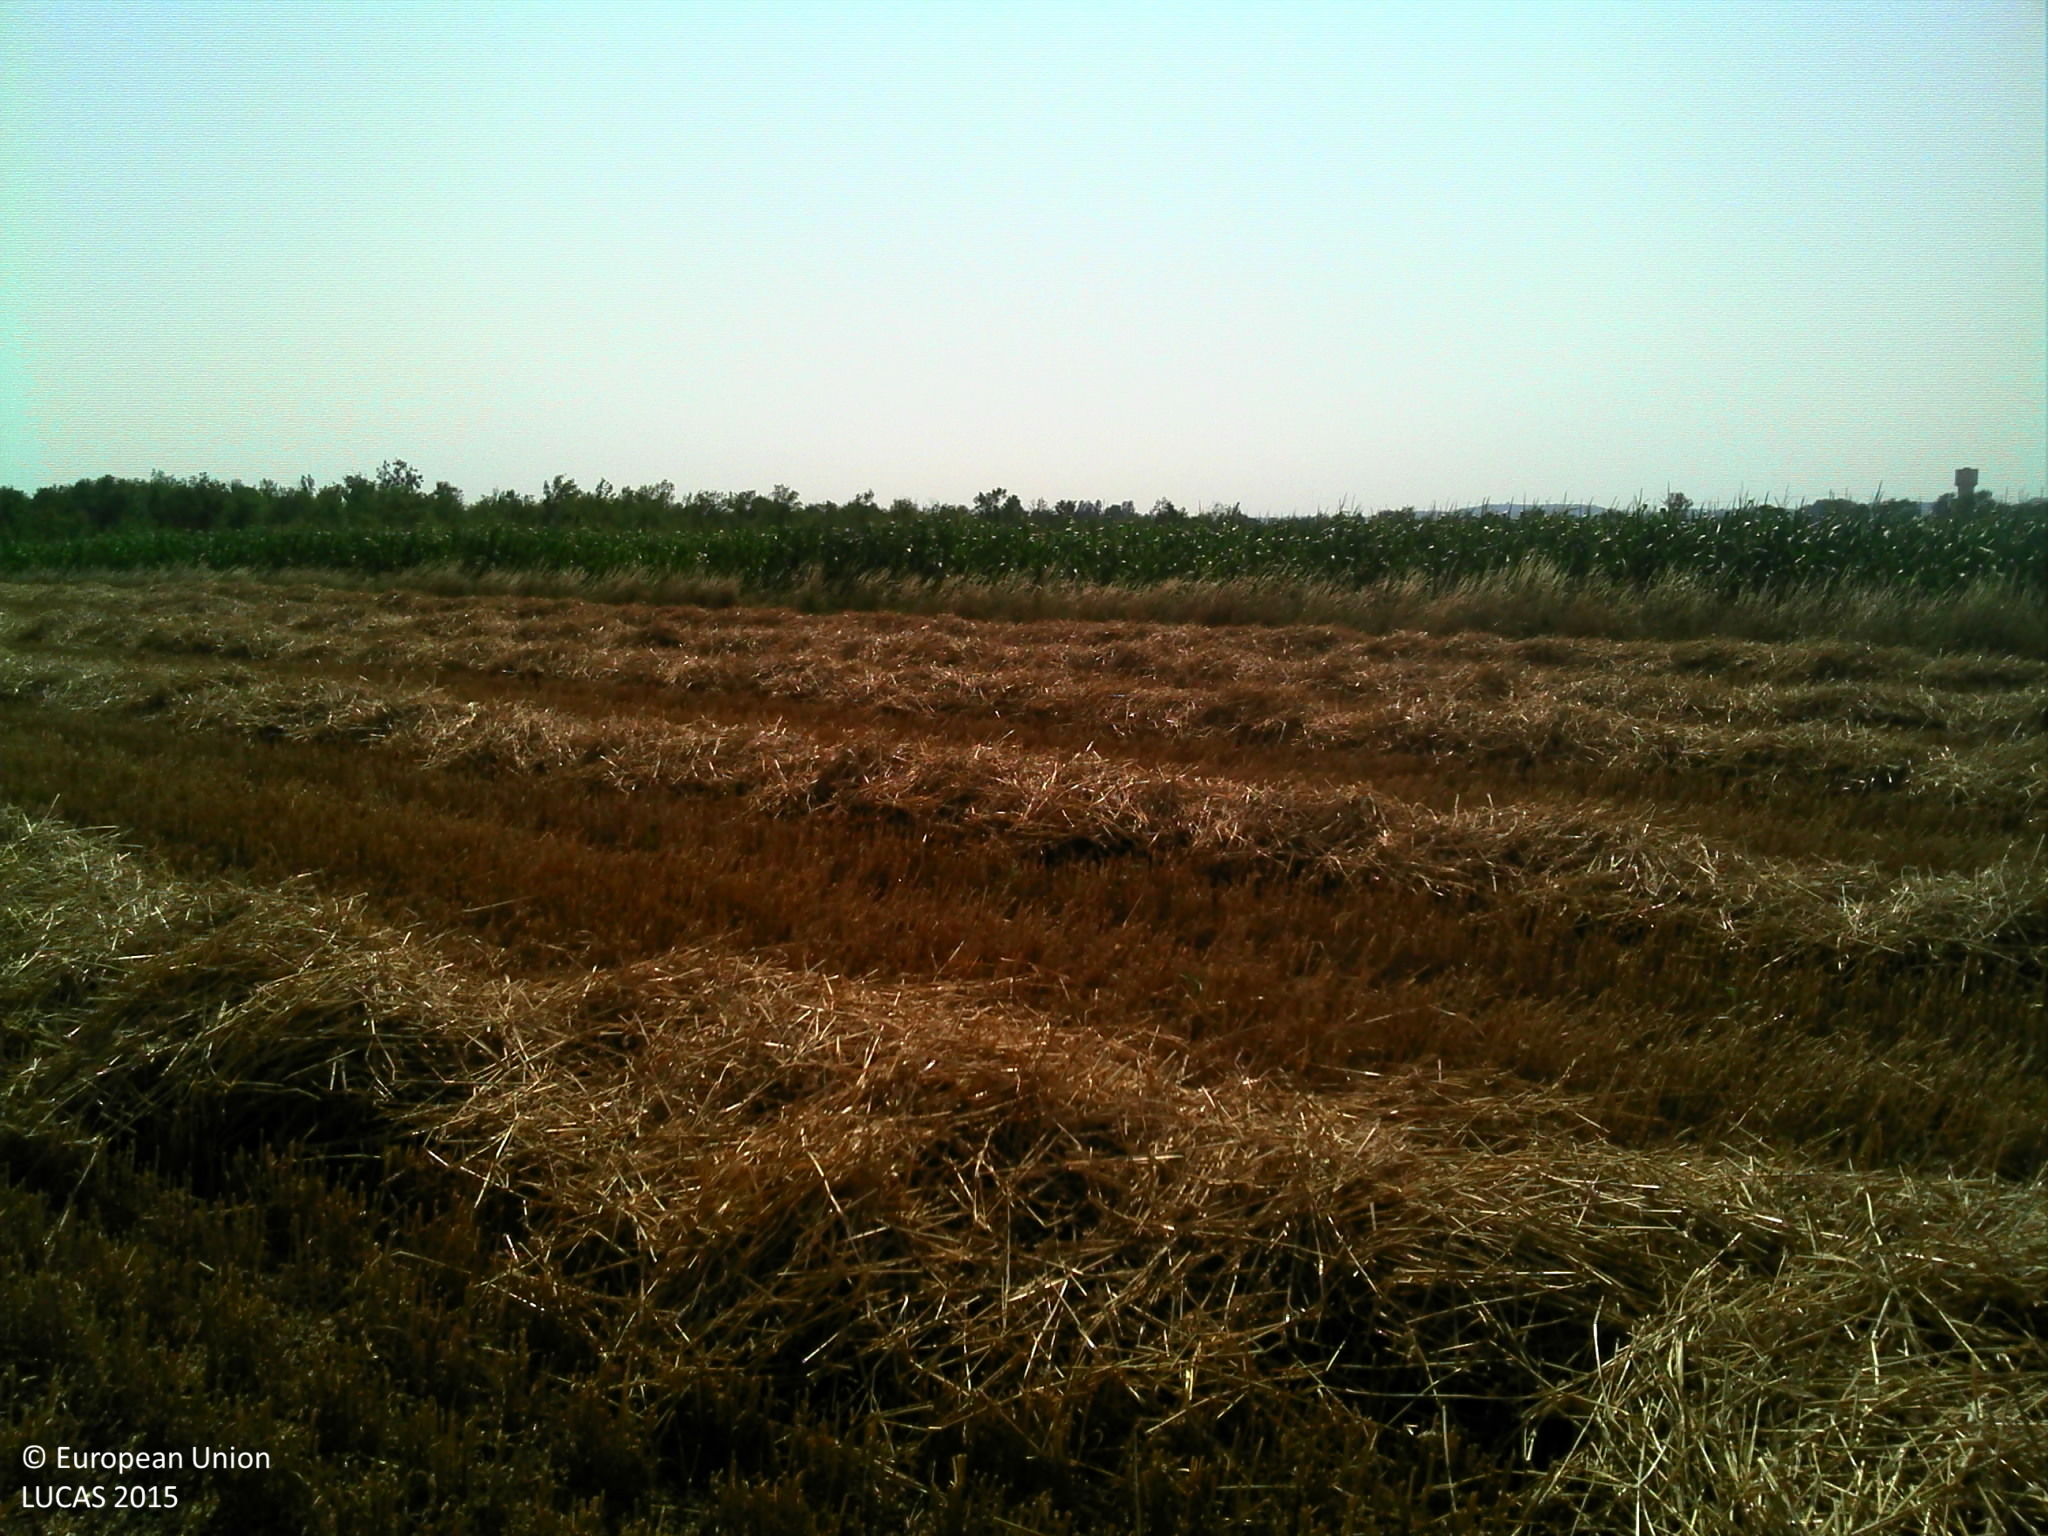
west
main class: Cropland
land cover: Common wheat
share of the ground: > 75 %
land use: Agriculture (excluding fallow land and kitchen gardens)
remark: Harvested field
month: July
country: FR
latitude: 43.4801
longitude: 2.0064
